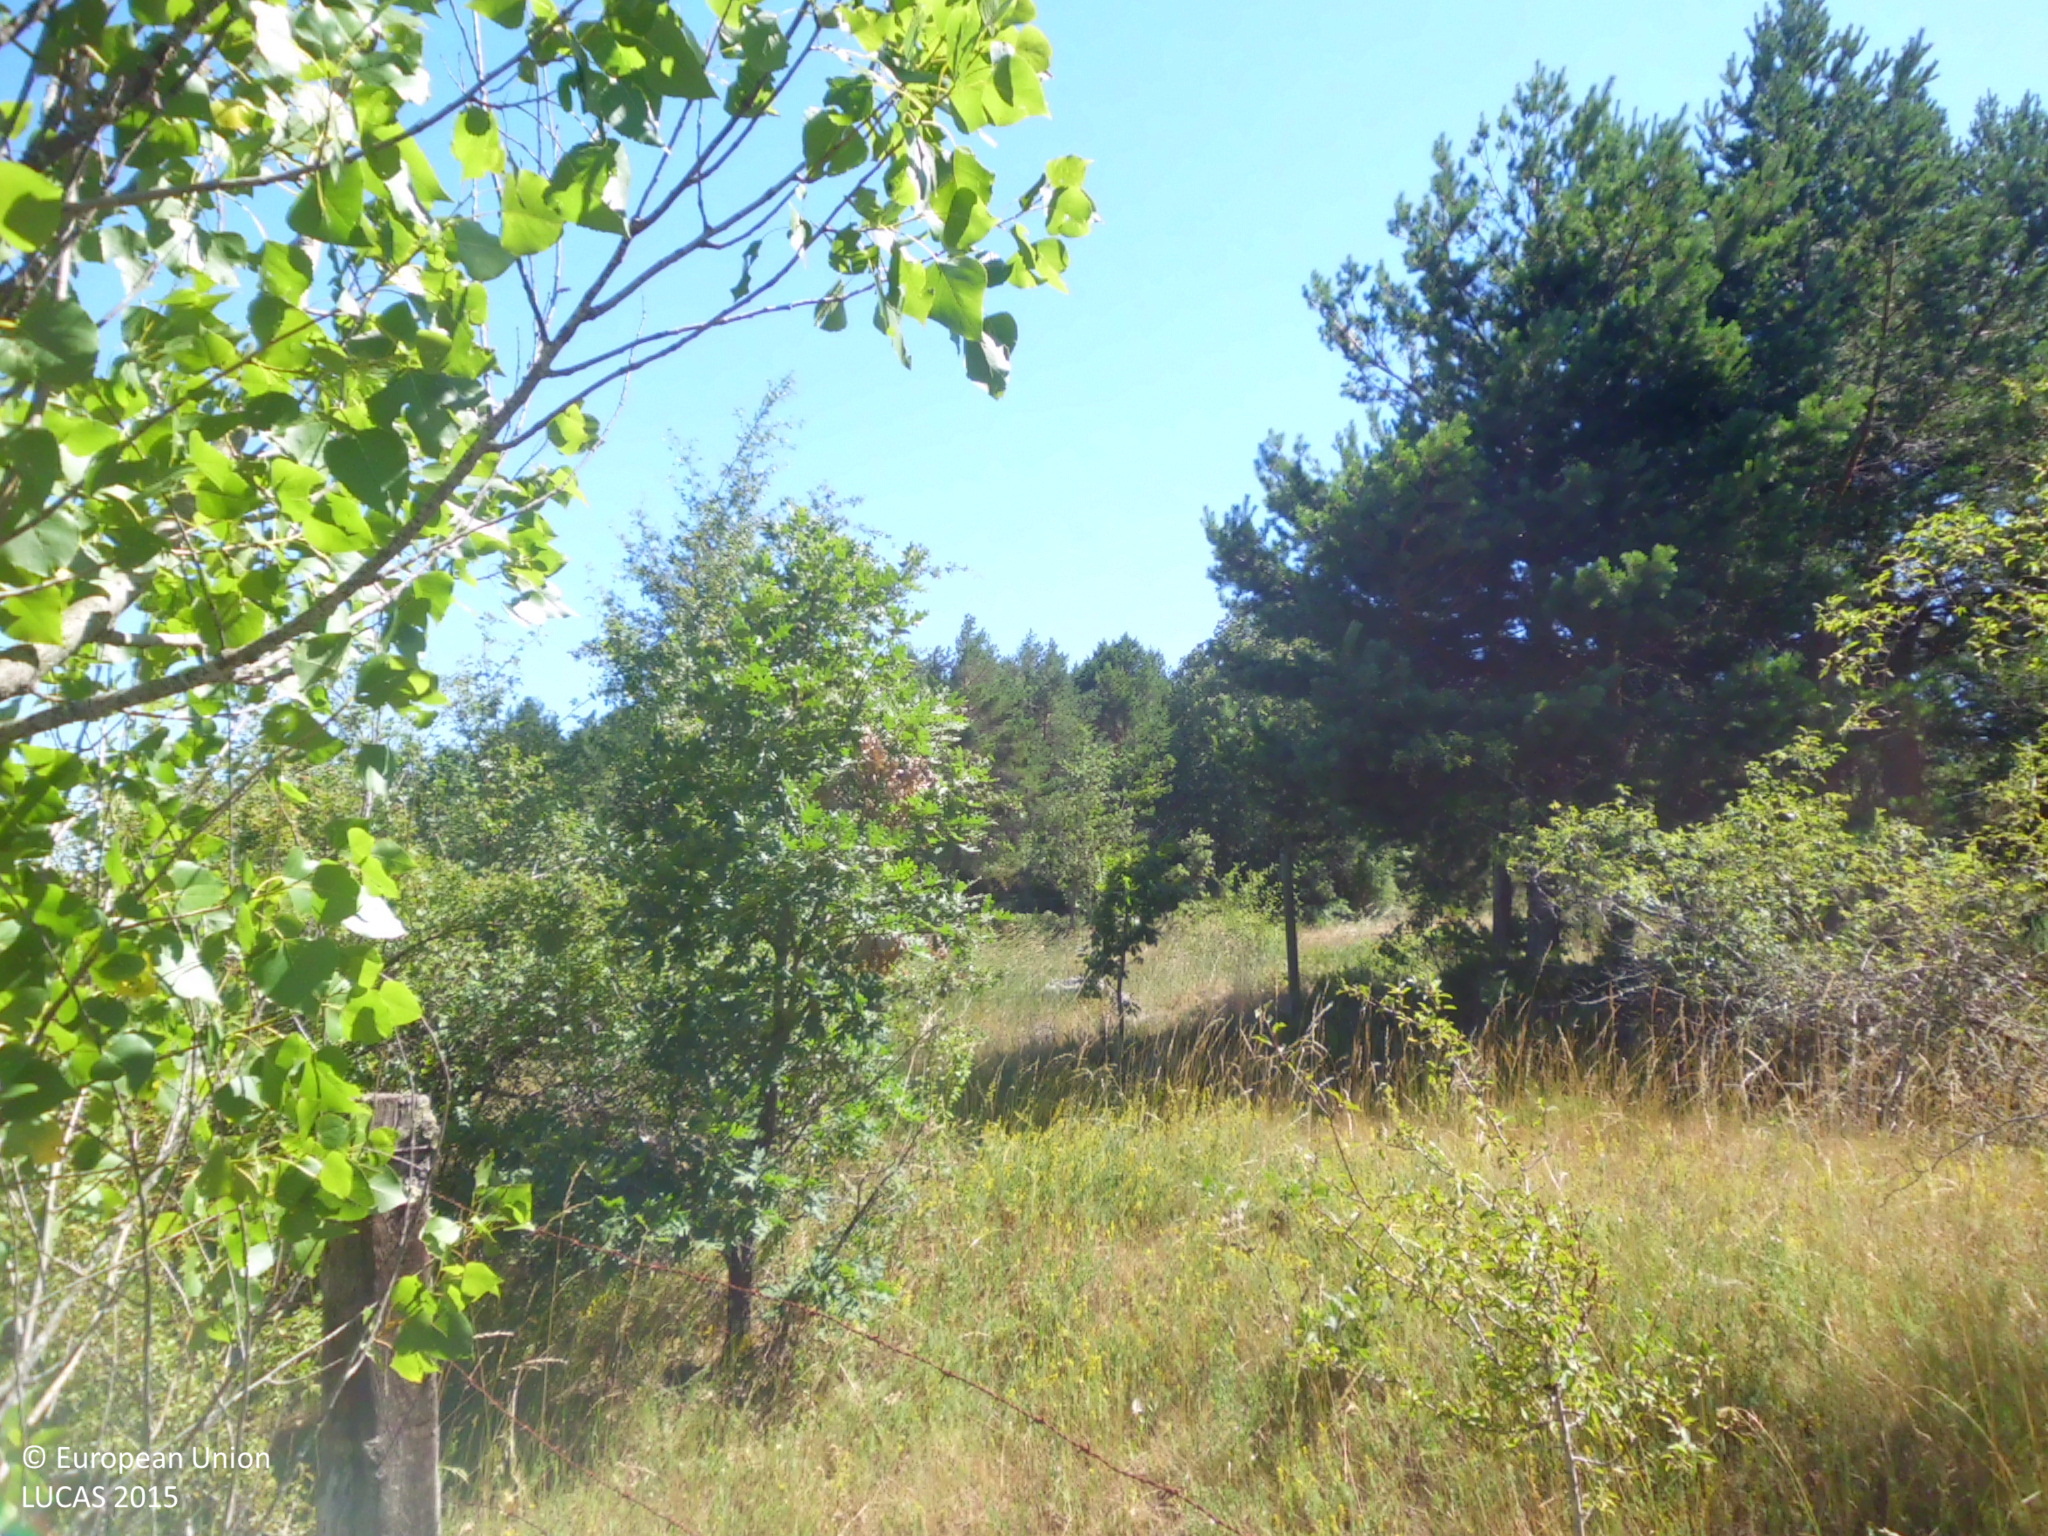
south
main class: Grassland
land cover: Grassland with sparse tree/shrub cover
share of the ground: > 75 %
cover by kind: herbaceous plants 95 %, broadleaved forest trees 5 %
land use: Semi-natural and natural areas not in use
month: July
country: ES
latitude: 42.7879
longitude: -4.2924
